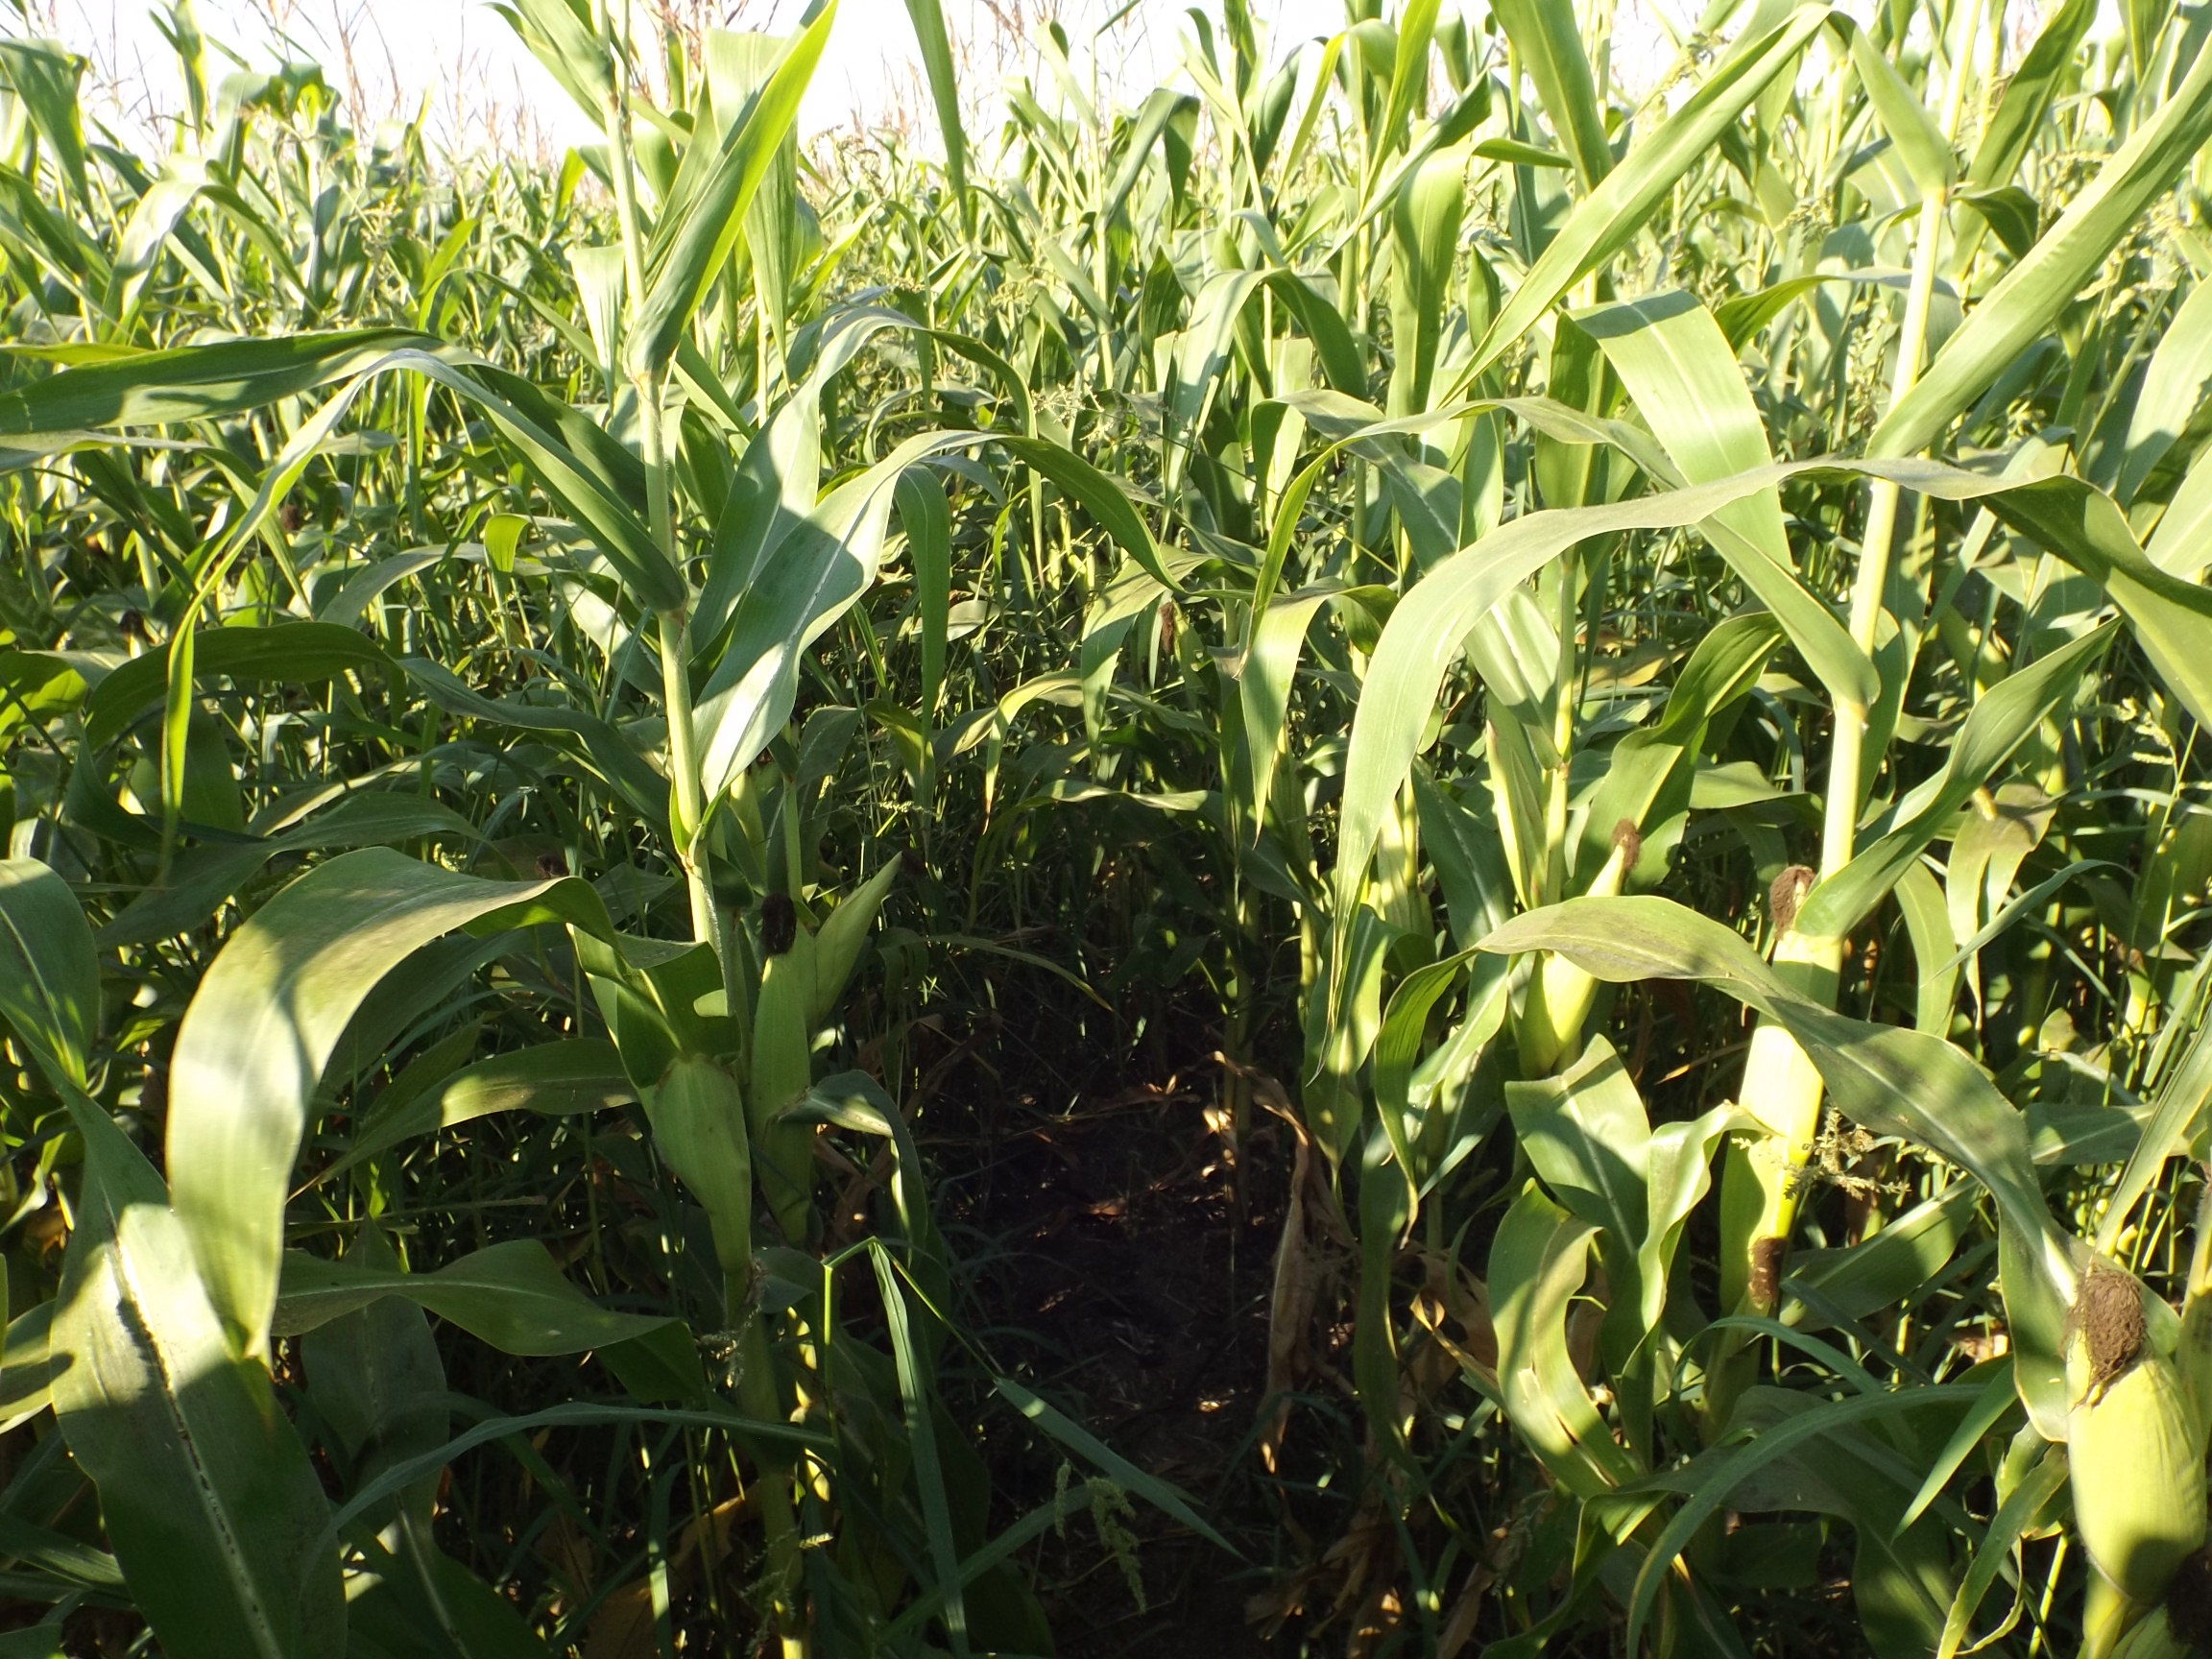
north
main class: Cropland
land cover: Maize
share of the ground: > 75 %
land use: Agriculture (excluding fallow land and kitchen gardens)
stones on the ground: < 10 %
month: August
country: BG
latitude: 43.3209
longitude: 27.9605
